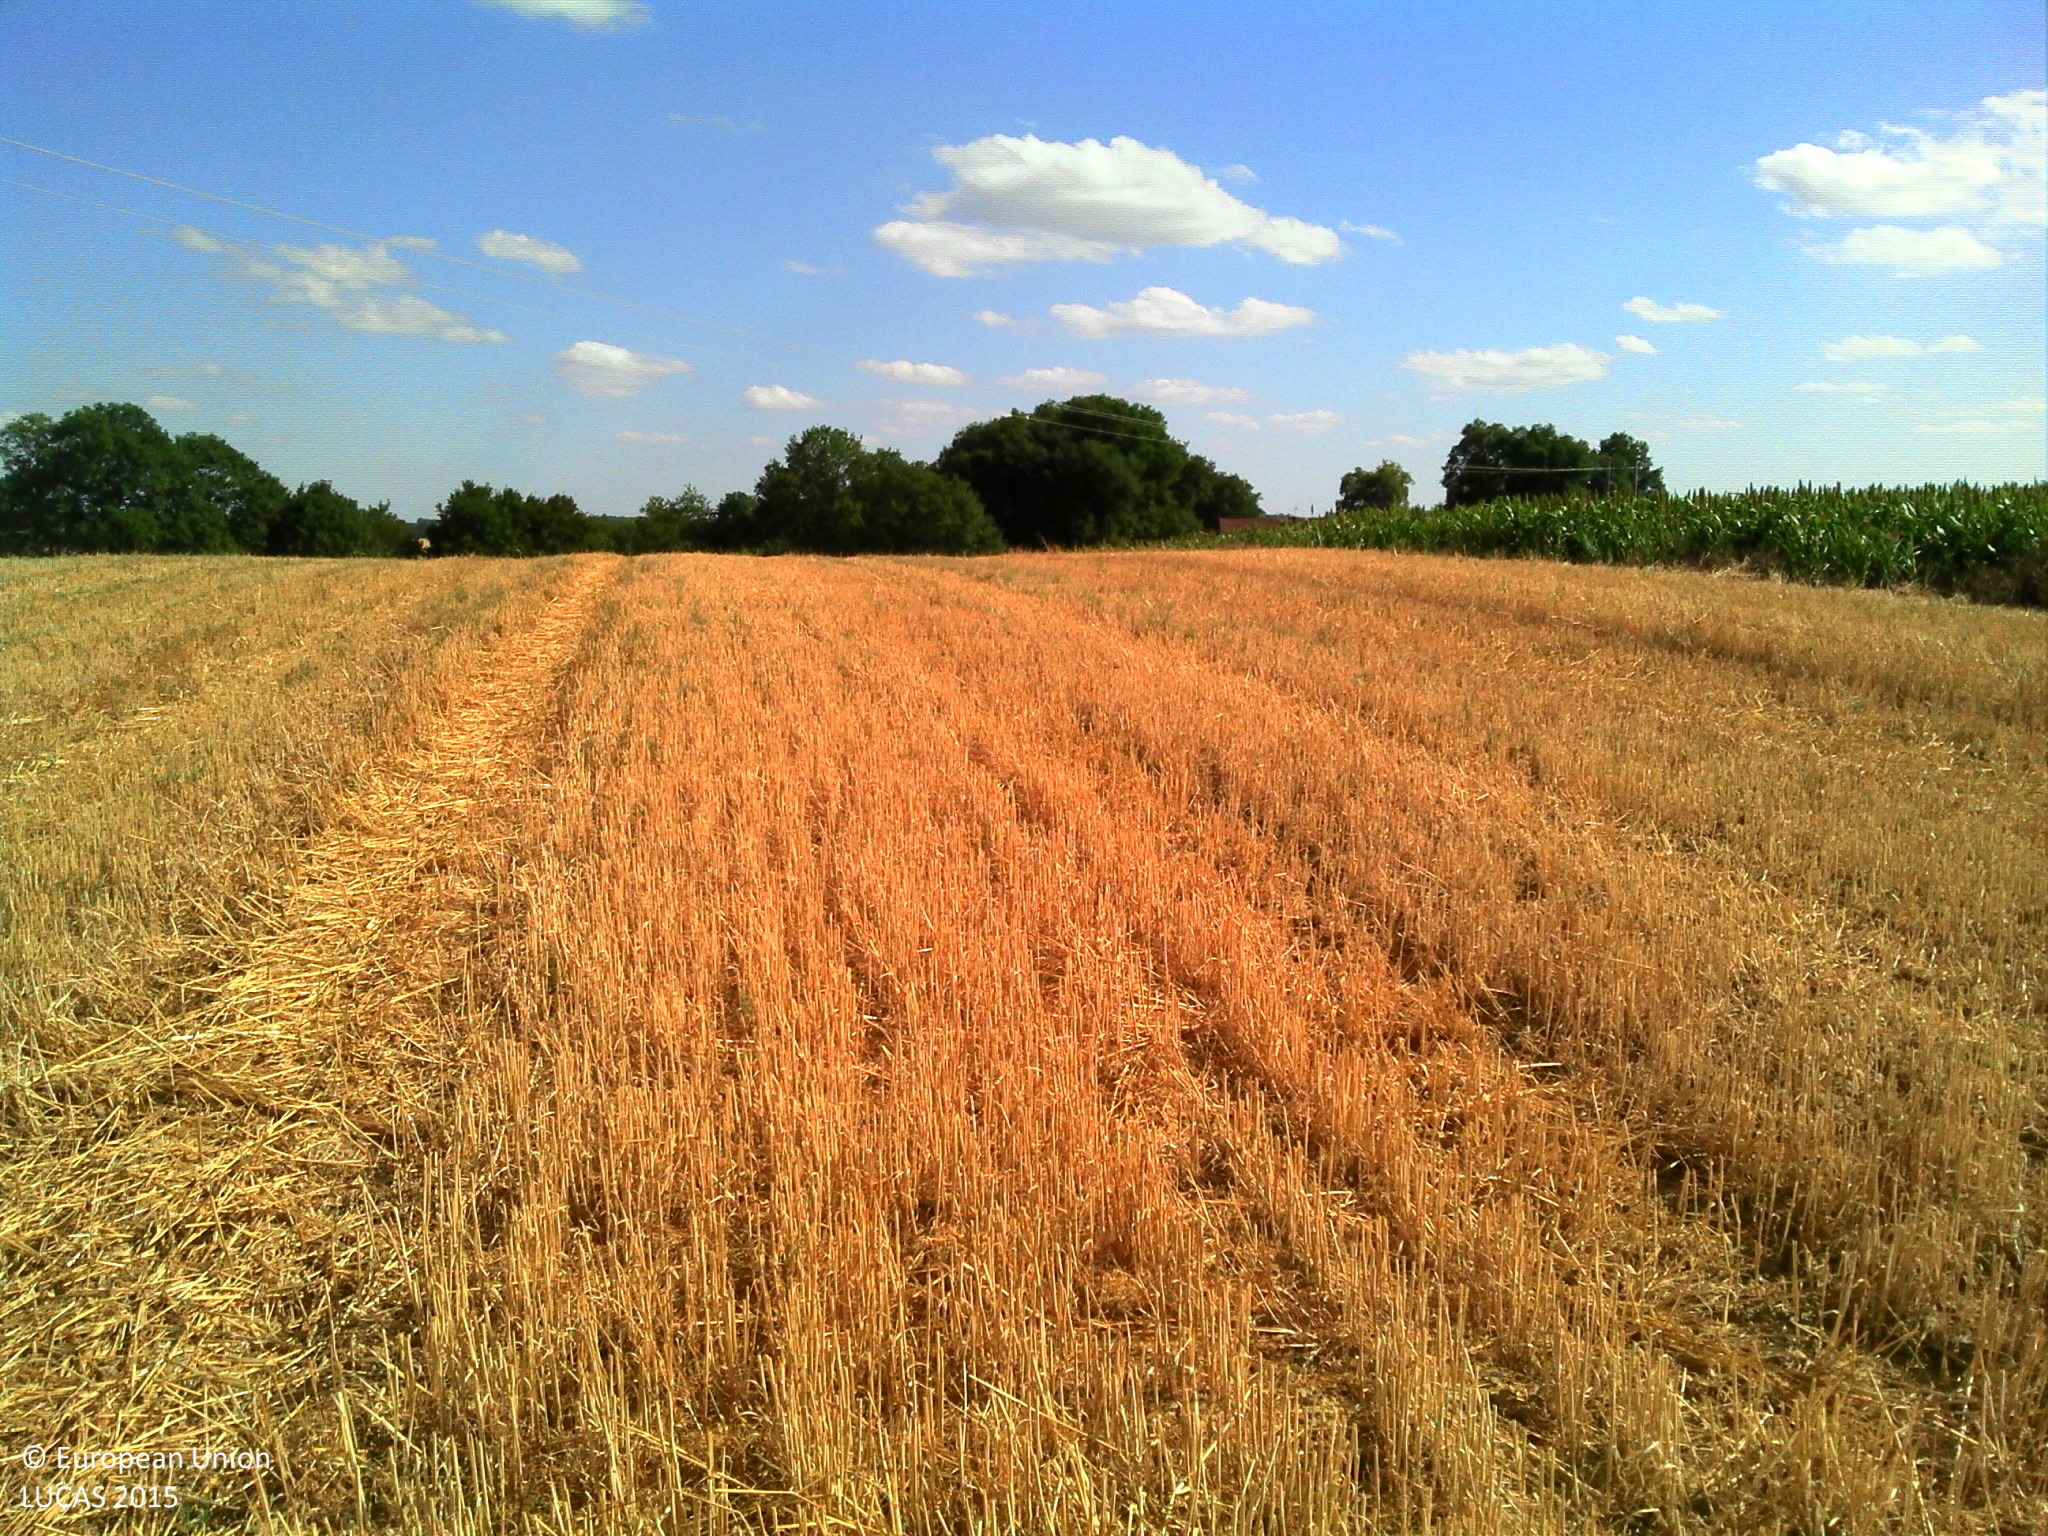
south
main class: Cropland
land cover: Common wheat
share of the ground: > 75 %
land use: Agriculture (excluding fallow land and kitchen gardens)
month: July
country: FR
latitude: 44.2890
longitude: 0.6330
